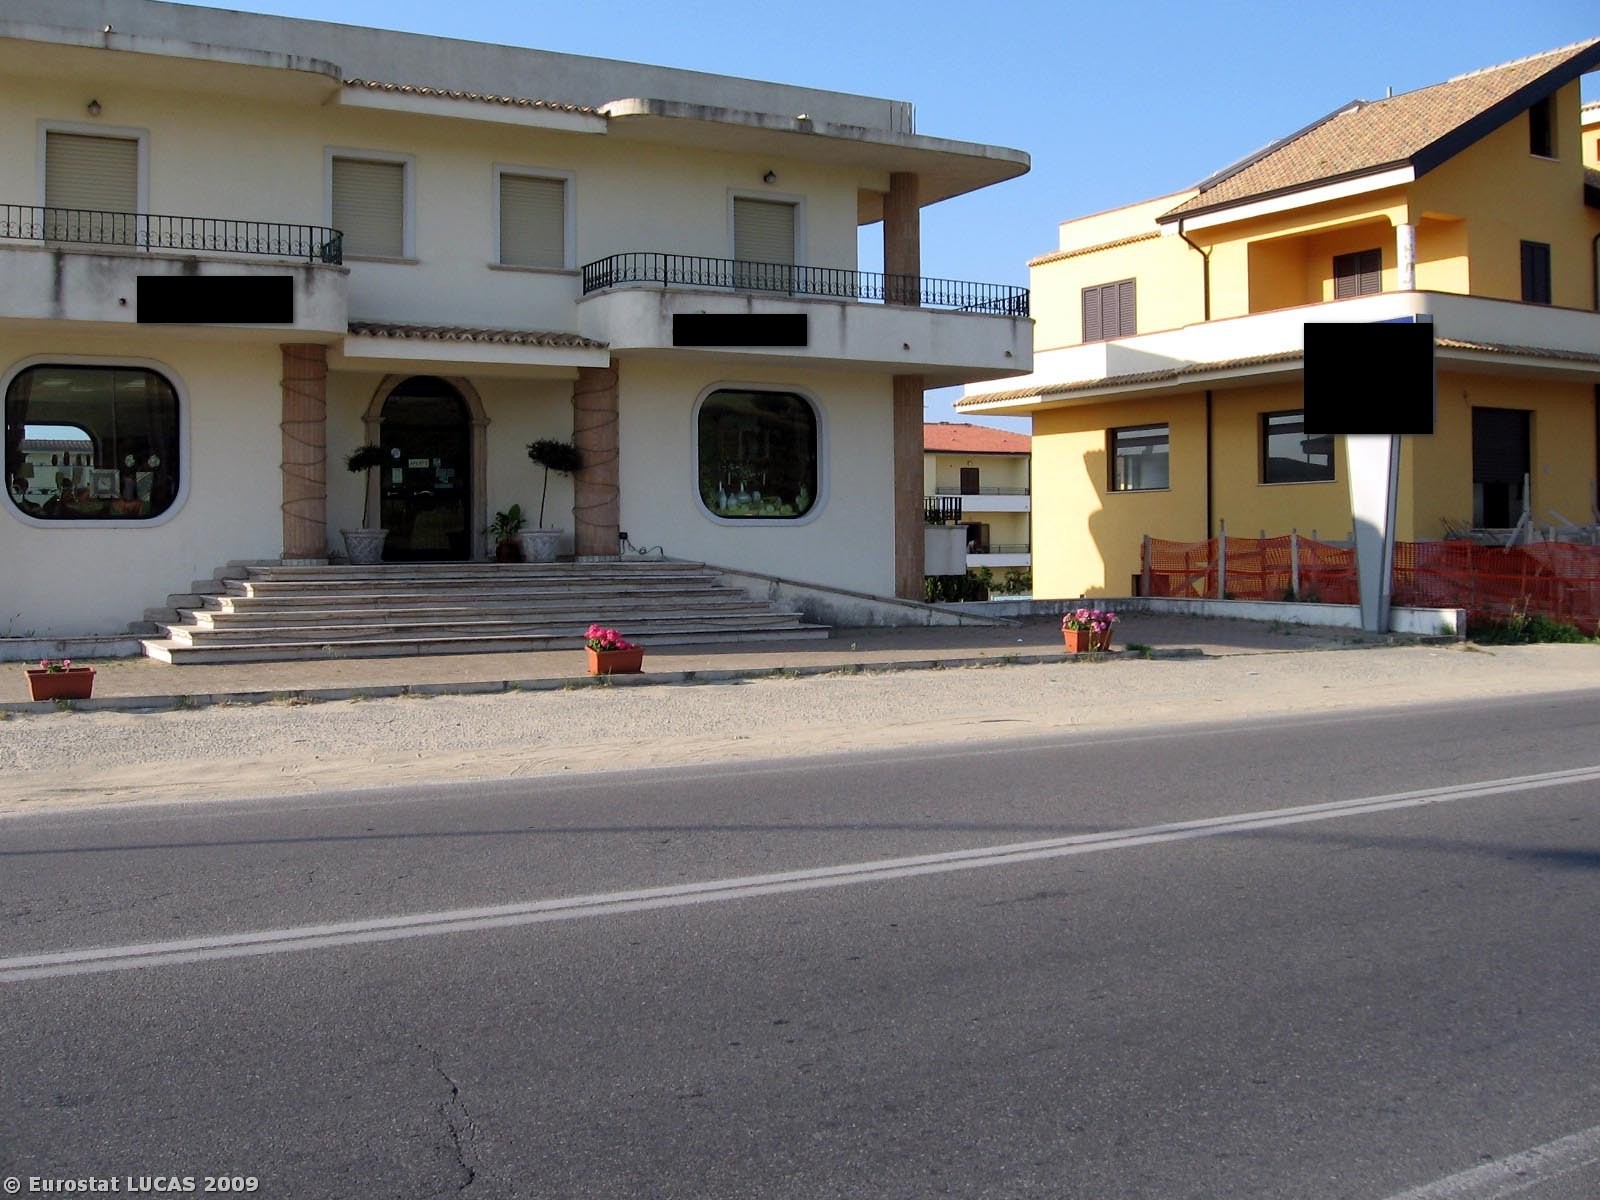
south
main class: Grassland
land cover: Spontaneously vegetated surfaces
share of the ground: > 75 %
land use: Fallow land
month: May
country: IT
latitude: 38.9226
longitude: 16.8054
